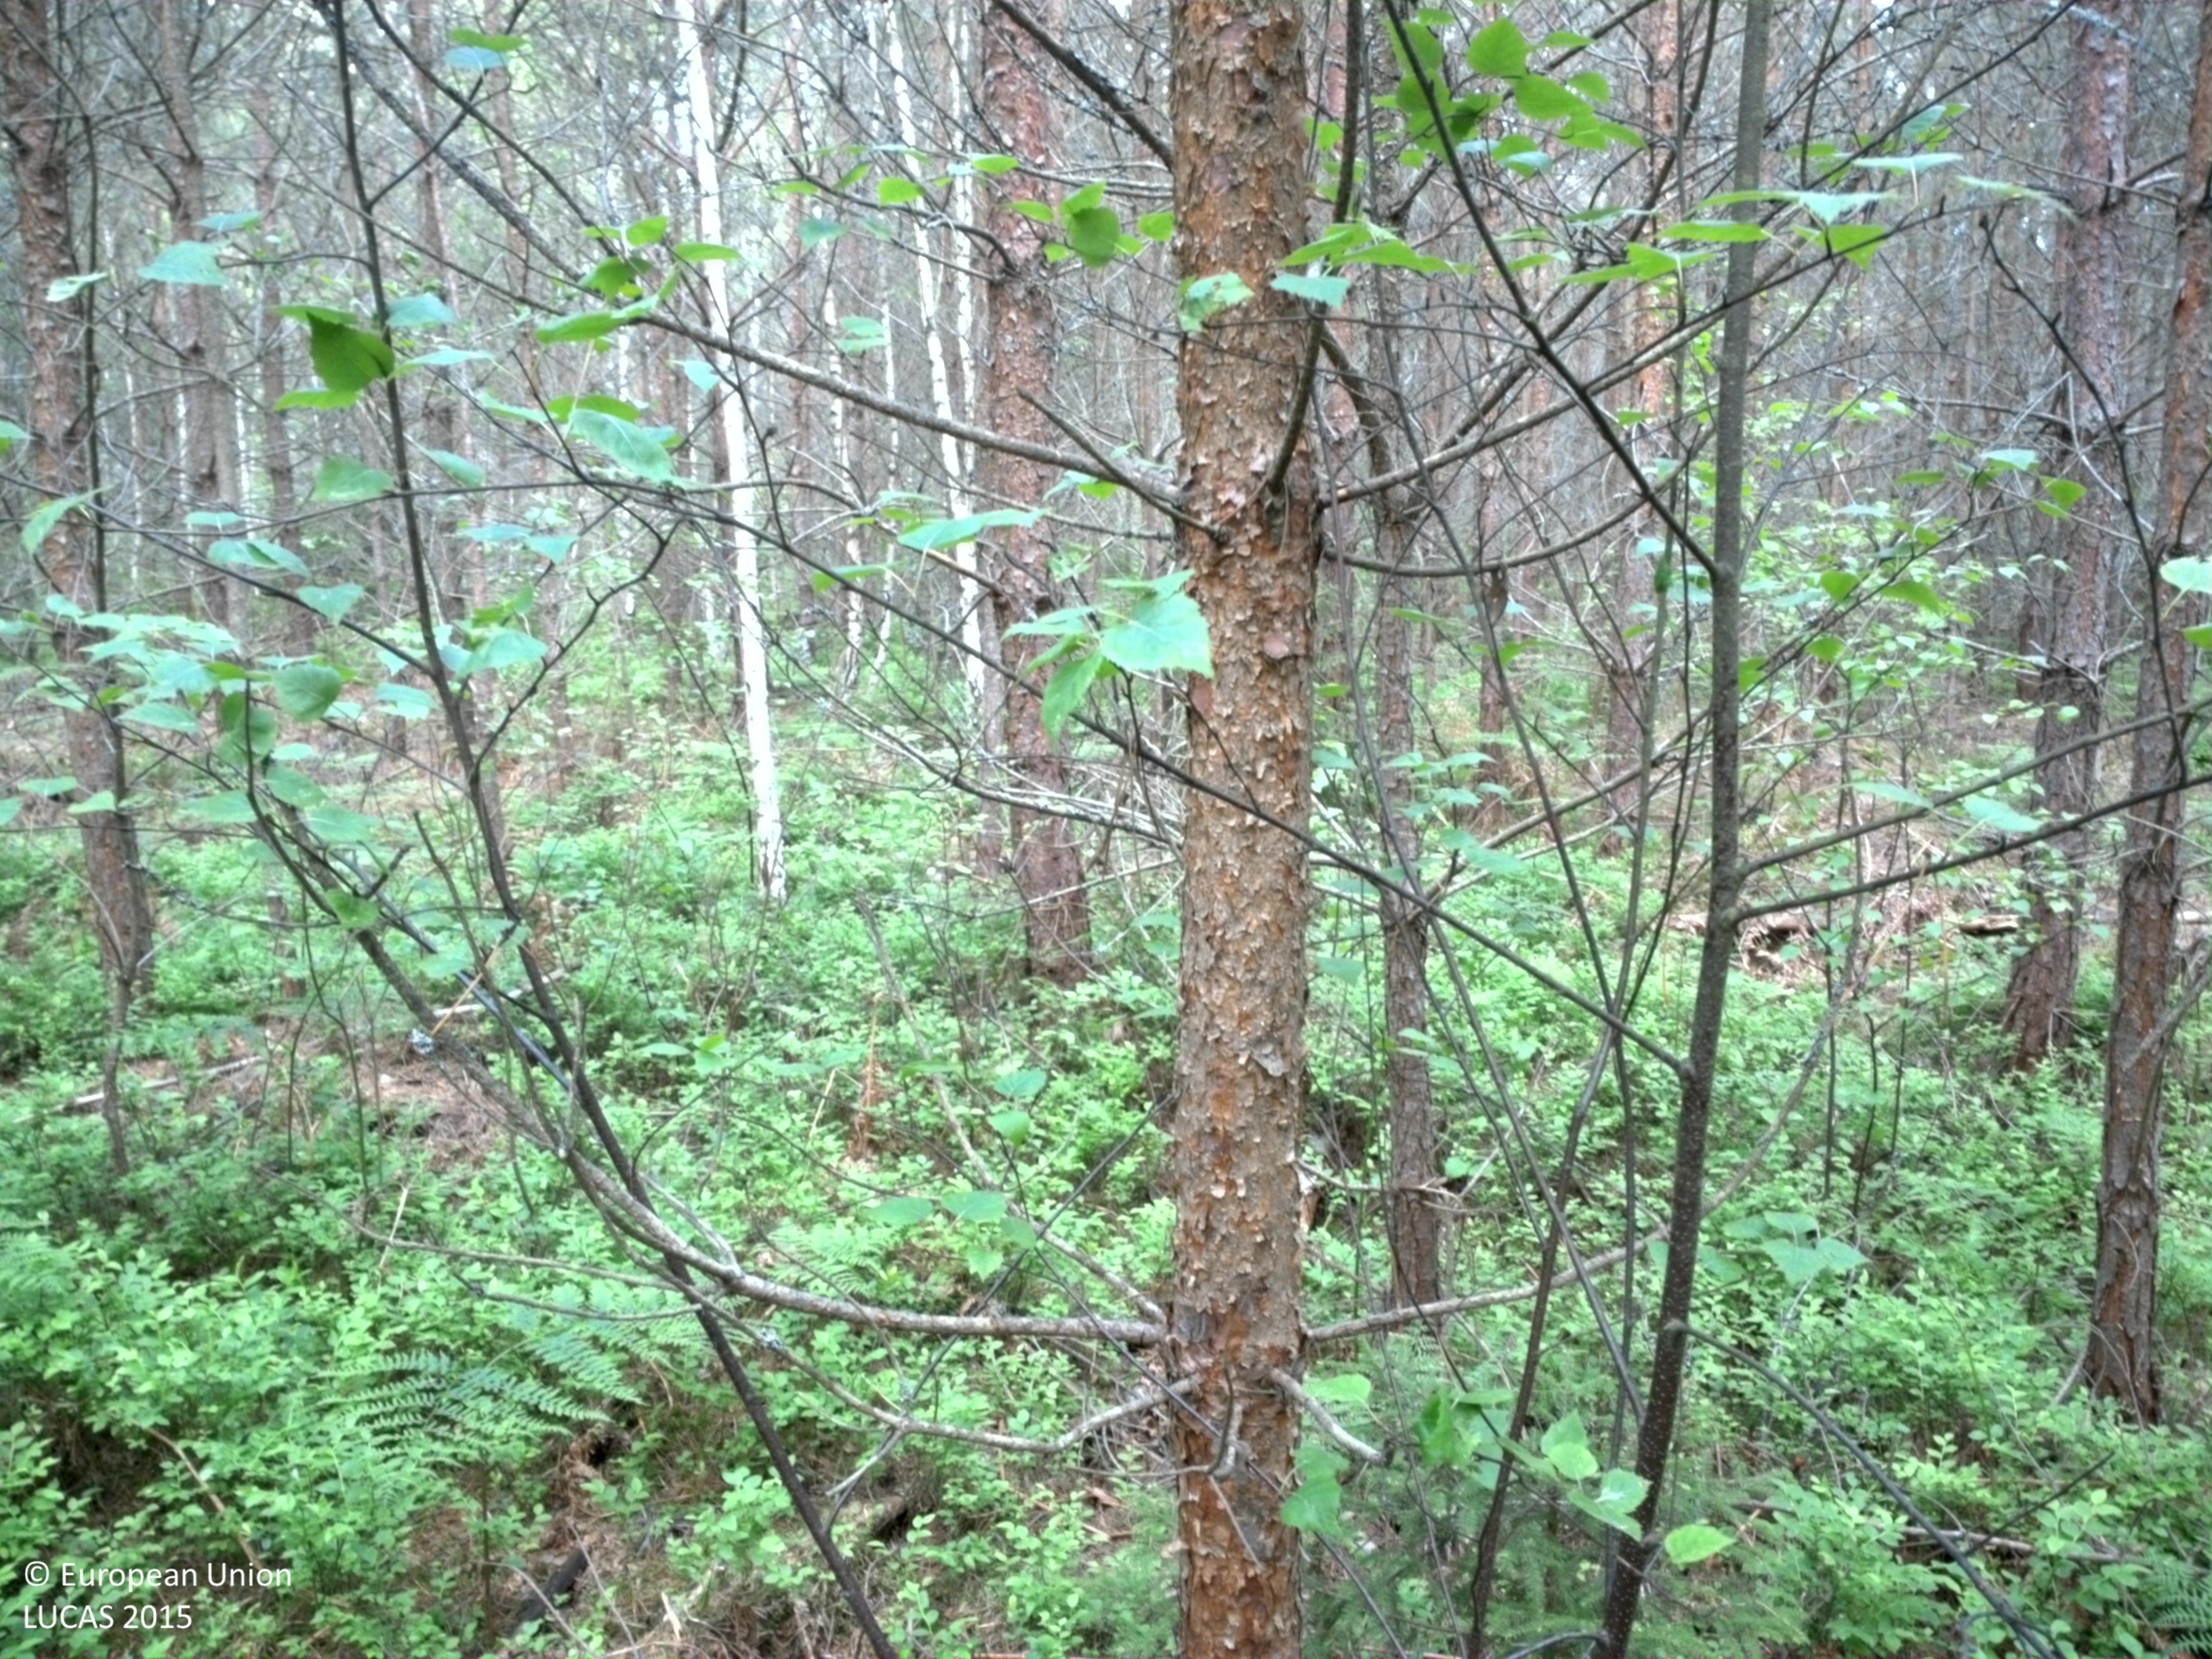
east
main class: Woodland
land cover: Pine dominated coniferous woodland
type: exotic forest
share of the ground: > 75 %
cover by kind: coniferous forest trees 85 %, shrubs 10 %, broadleaved forest trees 5 %
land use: Forestry
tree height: < 5 m
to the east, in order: Pine dominated coniferous woodland; Shrubland with sparse tree cover; Paved roads, cycling and walking lanes; Grass margins; Pine dominated coniferous woodland
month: May
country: SE
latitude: 57.0867
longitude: 16.5183
